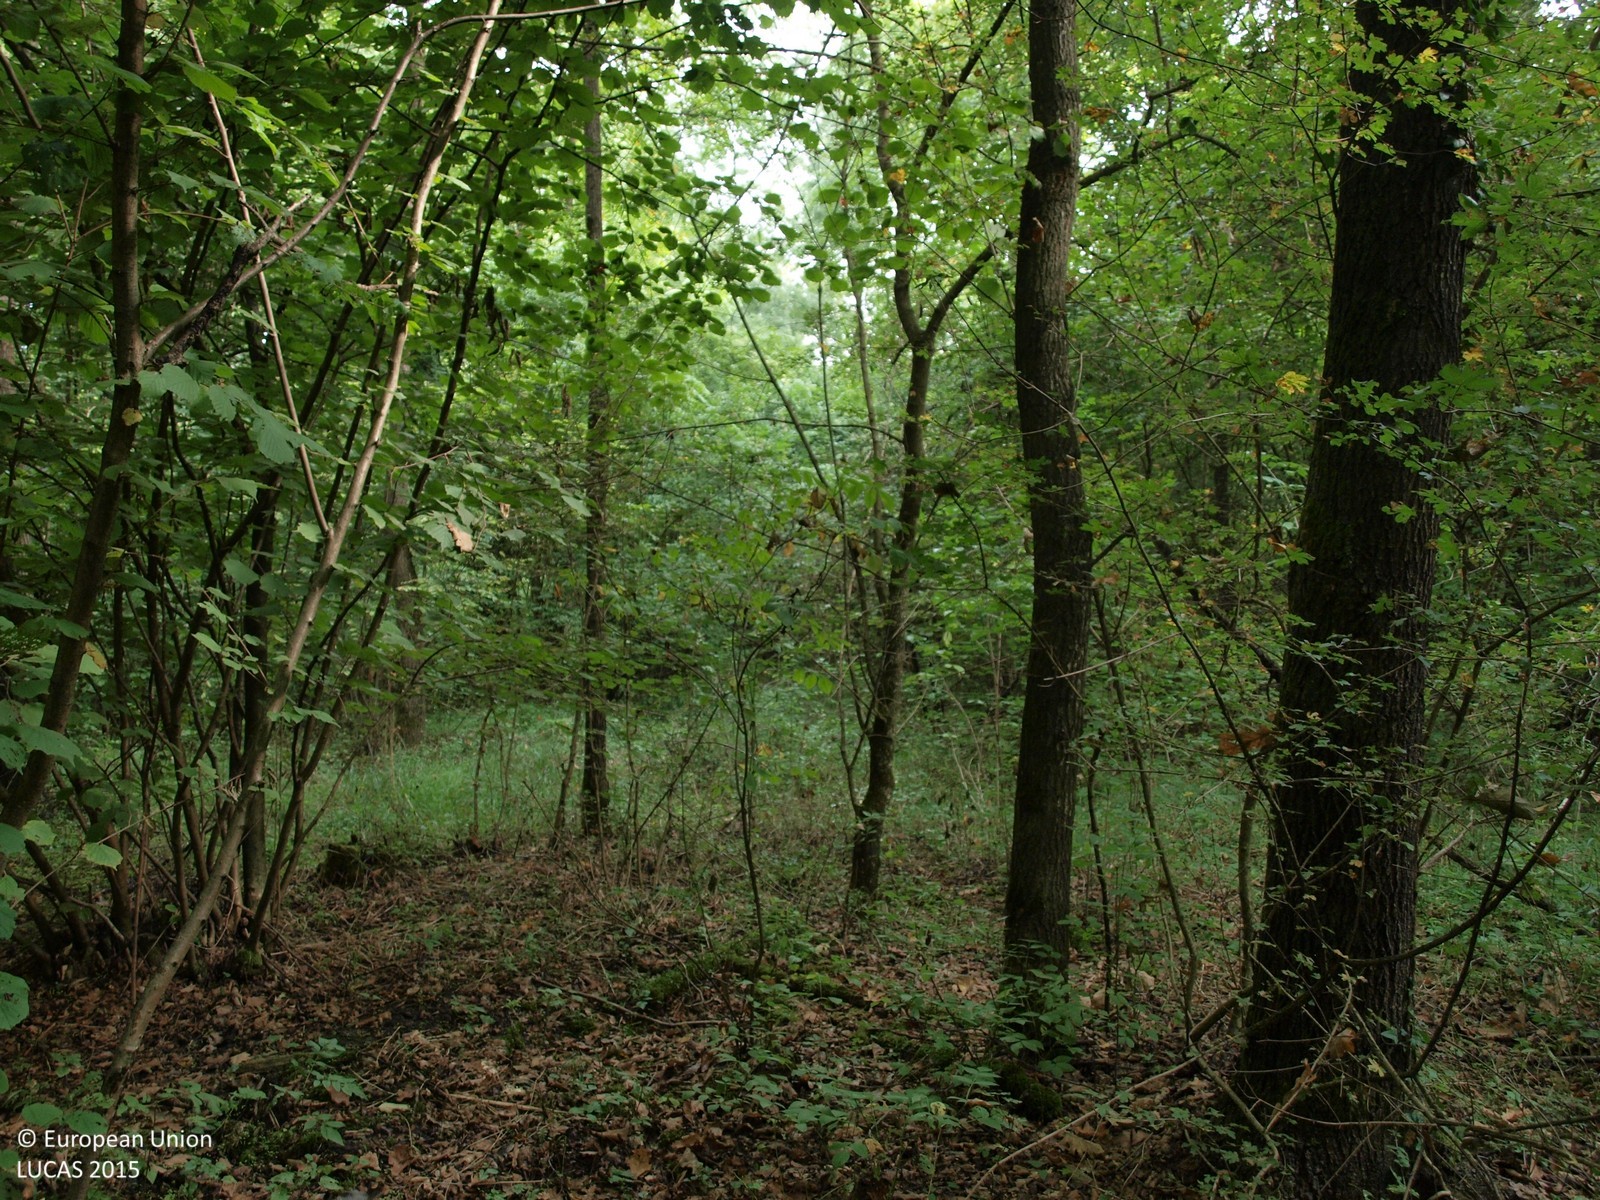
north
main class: Woodland
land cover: Broadleaved woodland
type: floodplain forest
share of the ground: > 75 %
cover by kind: broadleaved forest trees 100 %
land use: Forestry
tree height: > 5 m
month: September
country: HR
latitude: 45.7419
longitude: 16.1288
